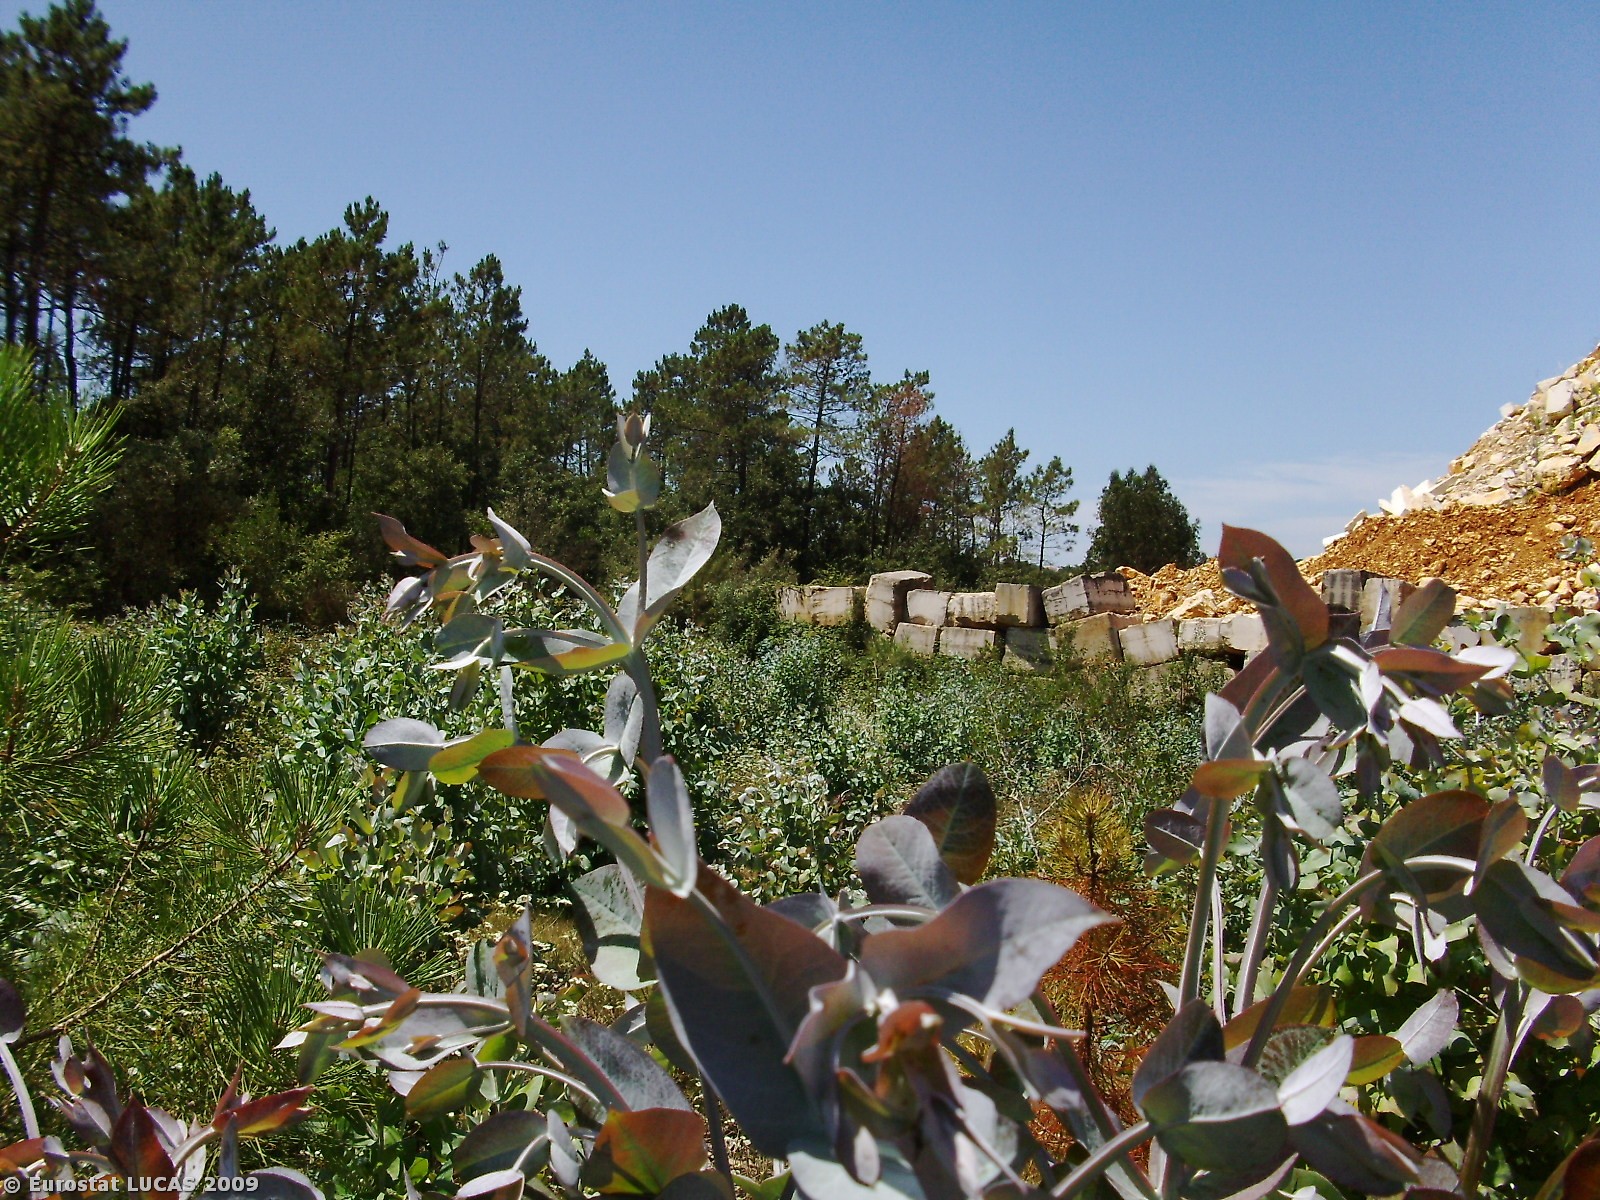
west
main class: Woodland
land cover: Broadleaved woodland
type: plantations and self-sown exotic forest
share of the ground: 50 - 75 %
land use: Forestry
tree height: > 5 m
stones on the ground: > 50 %
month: July
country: PT
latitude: 39.5586
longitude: -8.9049
